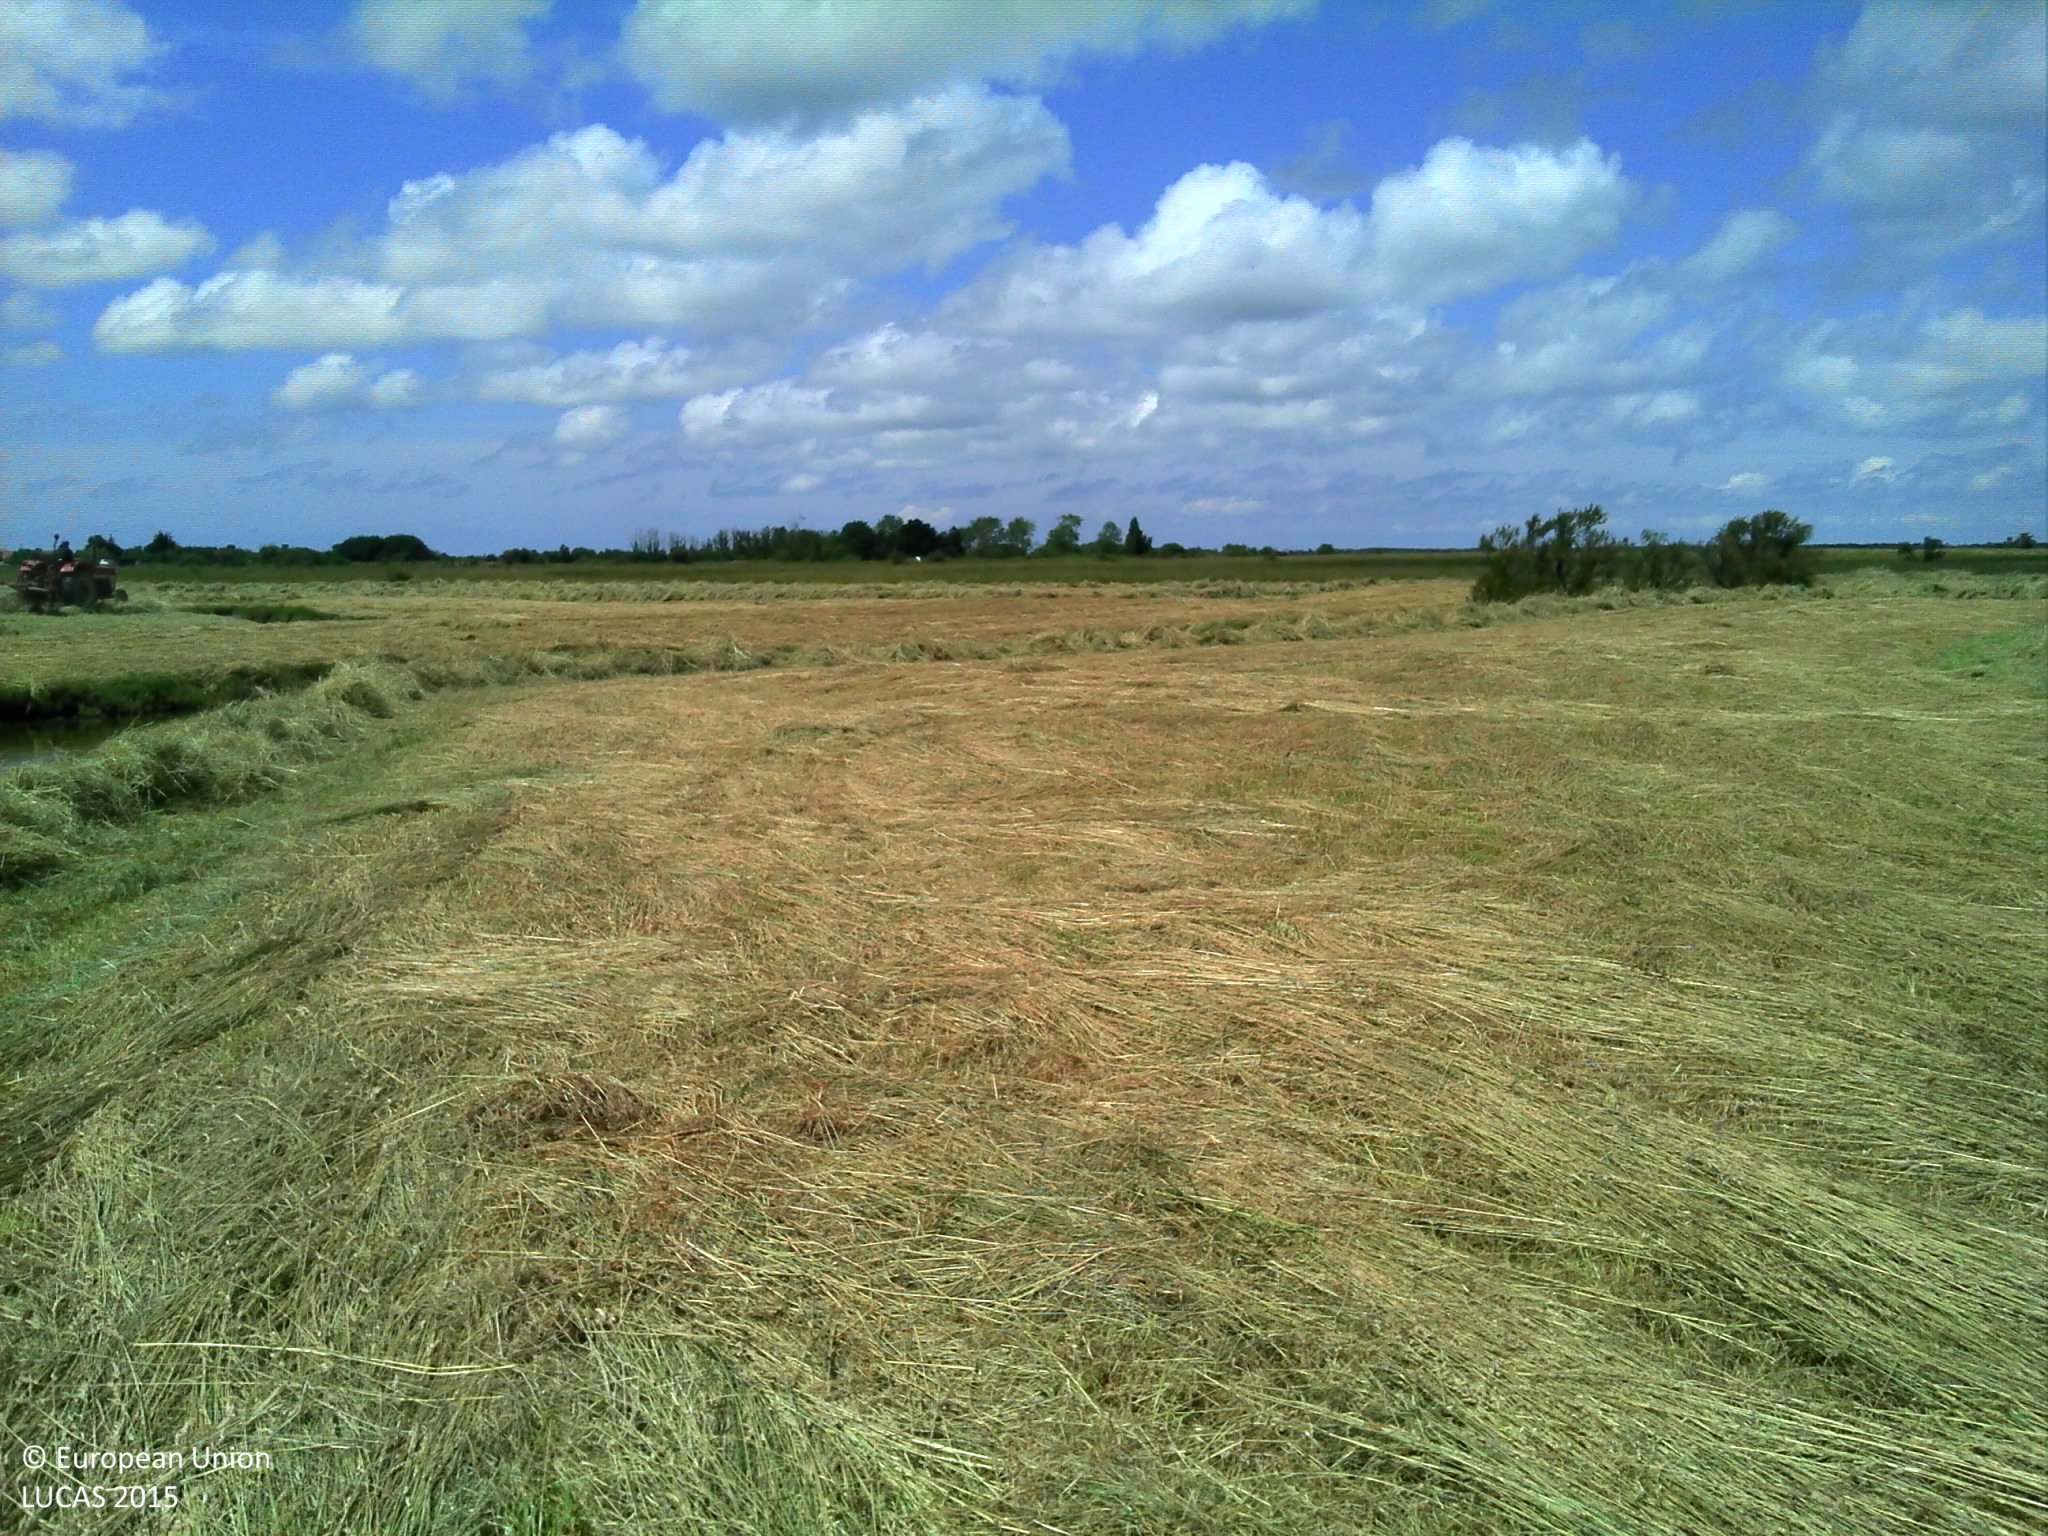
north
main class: Grassland
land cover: Grassland without tree/shrub cover
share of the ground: > 75 %
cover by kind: herbaceous plants 100 %
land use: Agriculture (excluding fallow land and kitchen gardens)
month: May
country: FR
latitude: 45.9358
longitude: -1.2657
